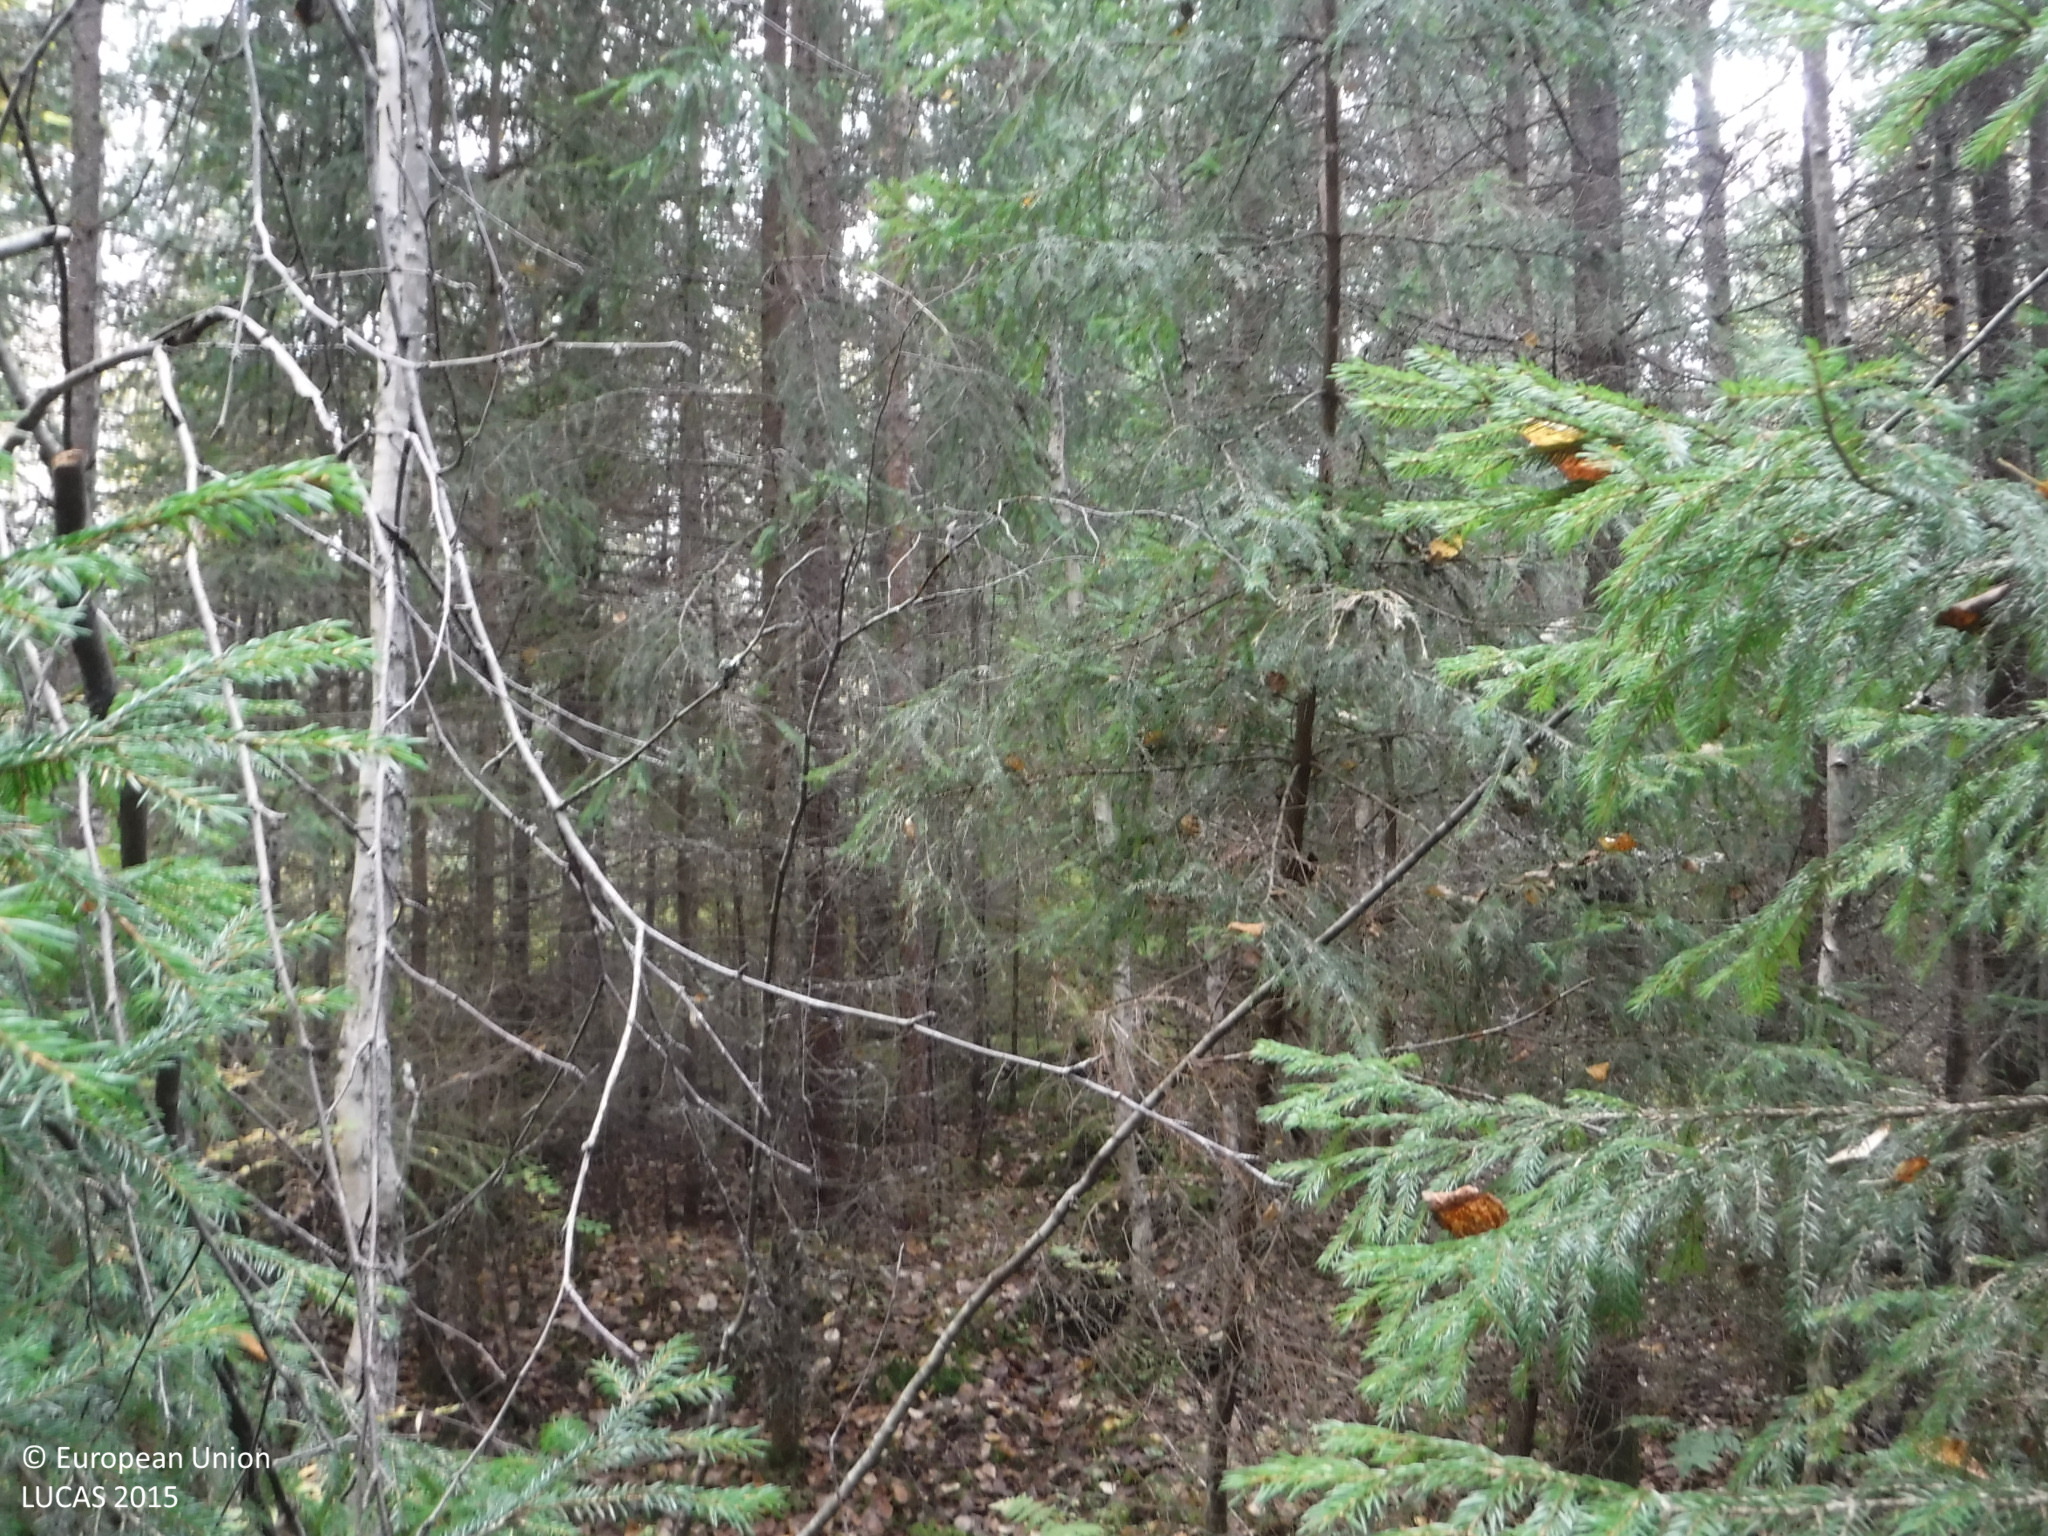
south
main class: Woodland
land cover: Spruce dominated mixed woodland
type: boreal forest
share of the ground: > 75 %
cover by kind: coniferous forest trees 40 %, broadleaved forest trees 40 %, lichens and mosses 15 %, shrubs 5 %
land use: Forestry
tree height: > 5 m
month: September
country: FI
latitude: 61.5470
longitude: 24.0307
